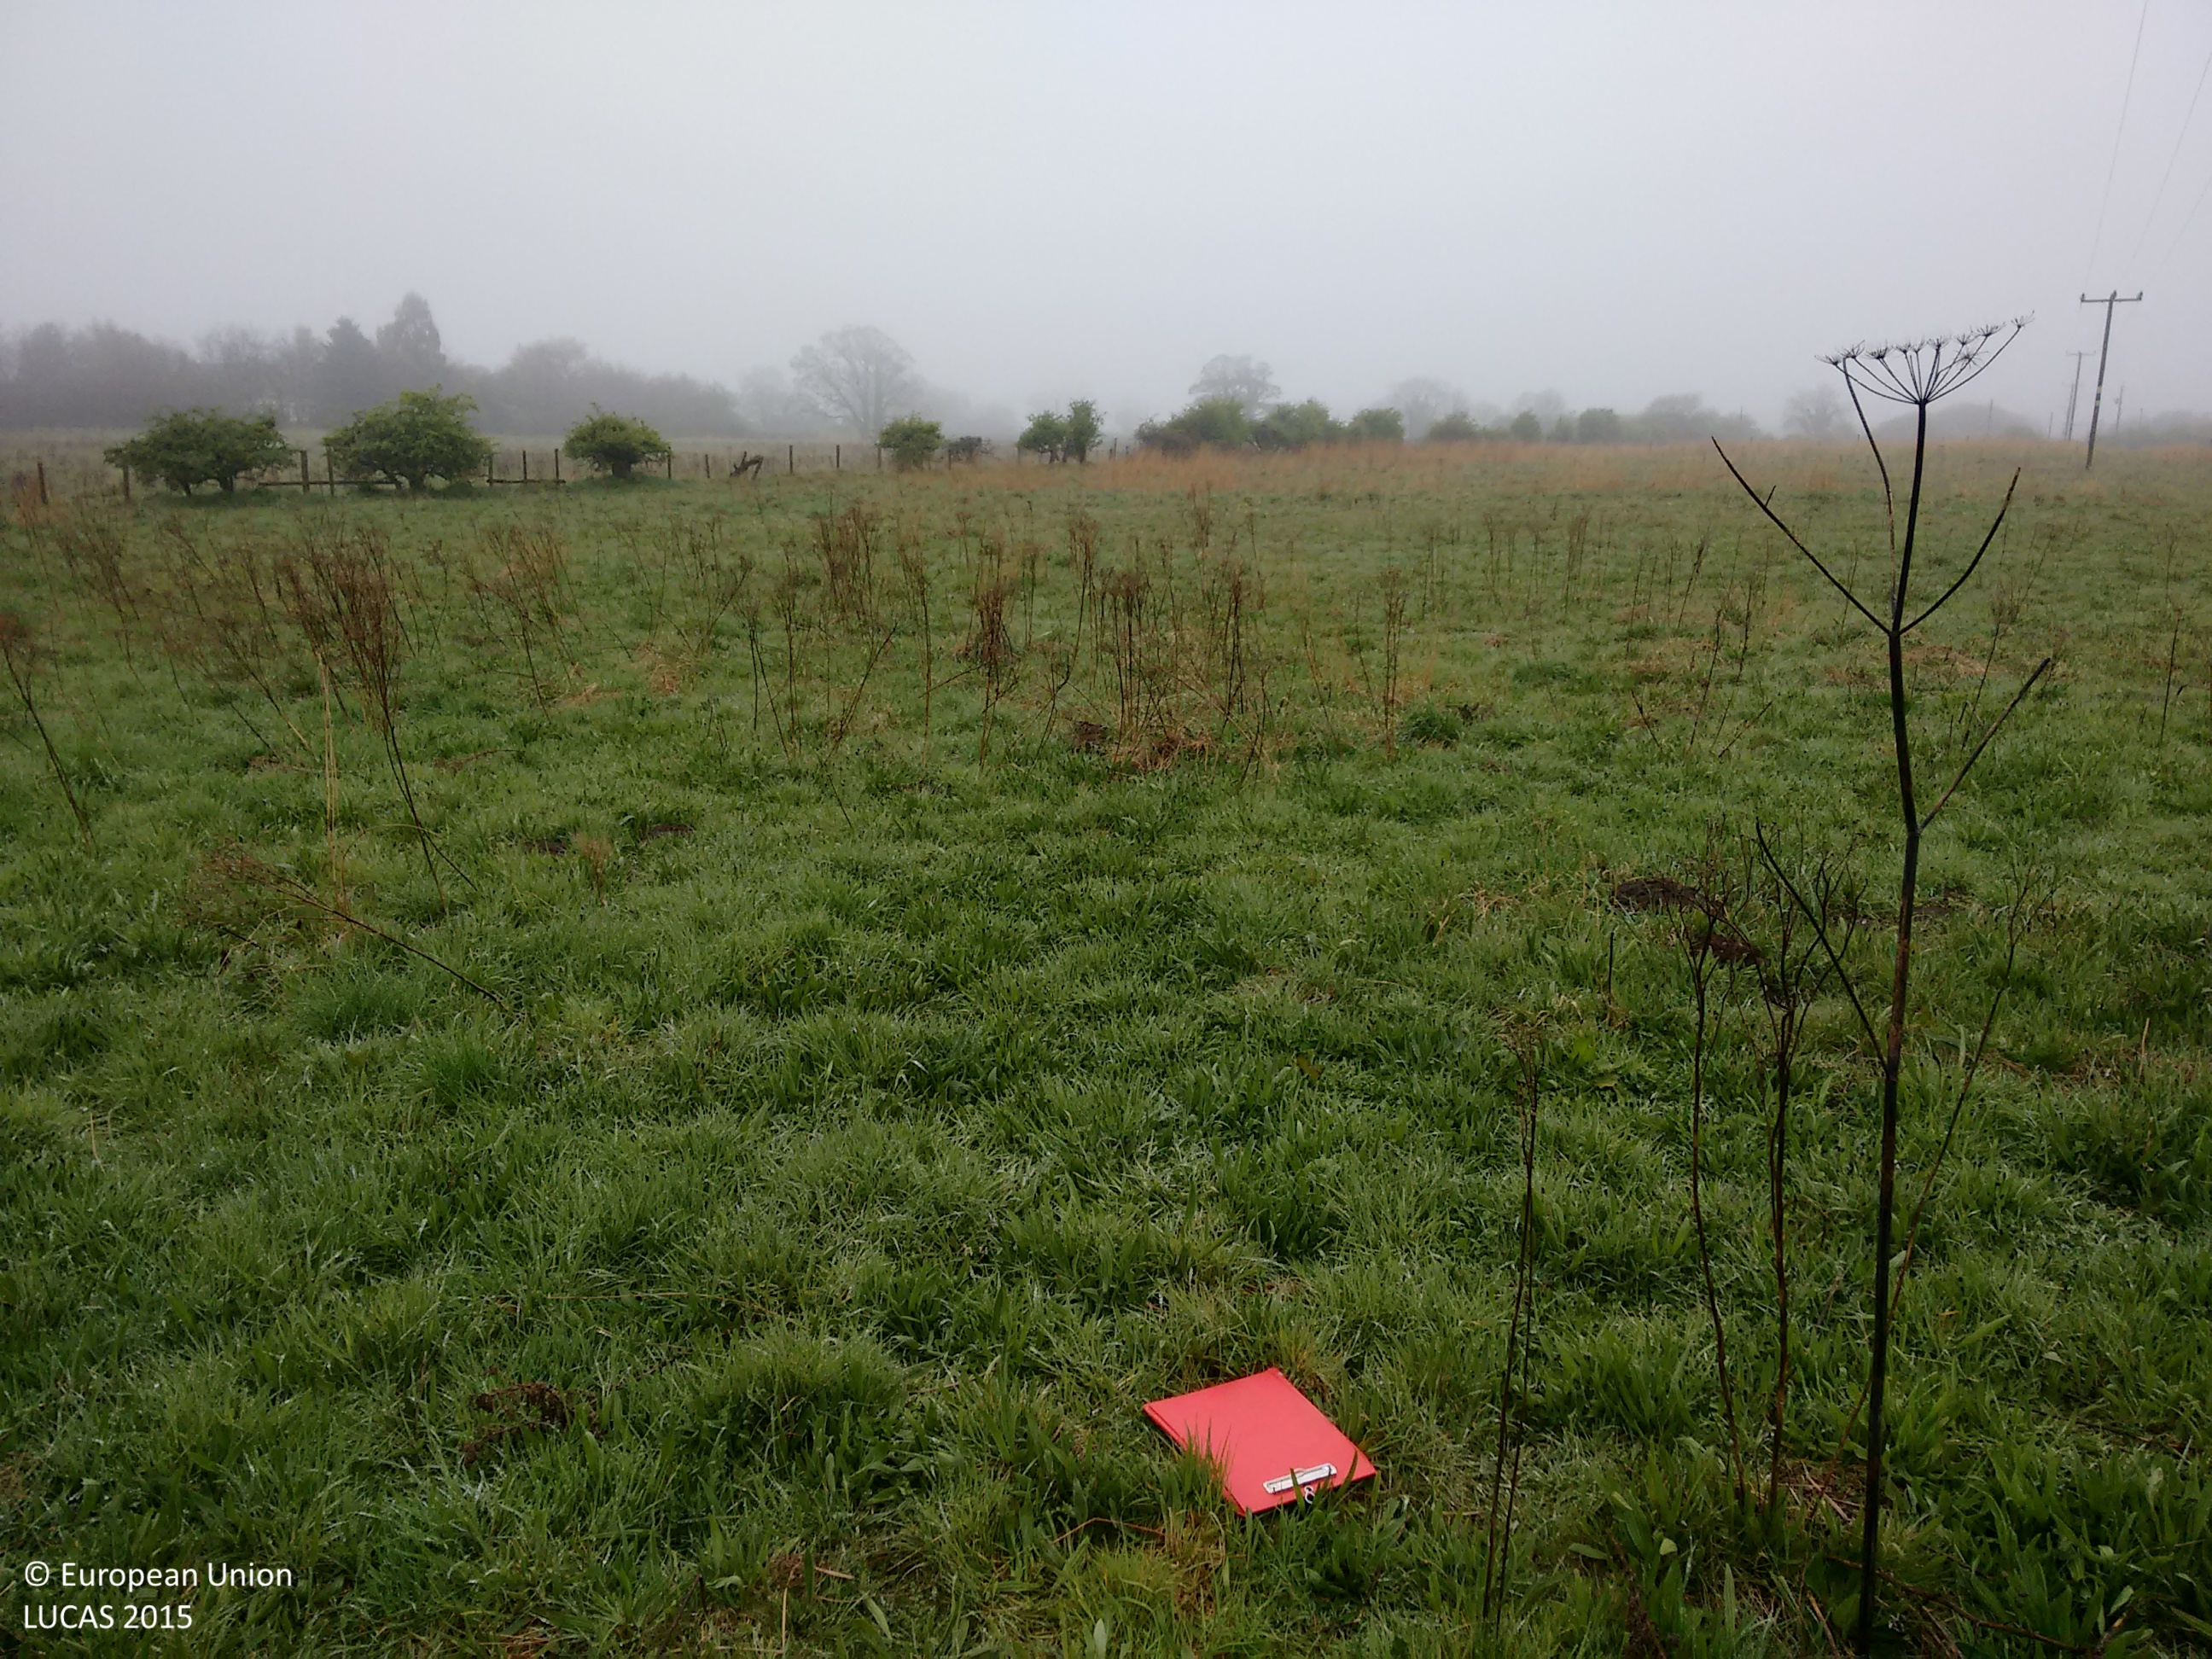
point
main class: Grassland
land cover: Grassland without tree/shrub cover
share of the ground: > 75 %
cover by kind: herbaceous plants 100 %
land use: Agriculture (excluding fallow land and kitchen gardens)
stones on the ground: < 10 %
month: May
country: GB
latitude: 55.1641
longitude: -1.6491
